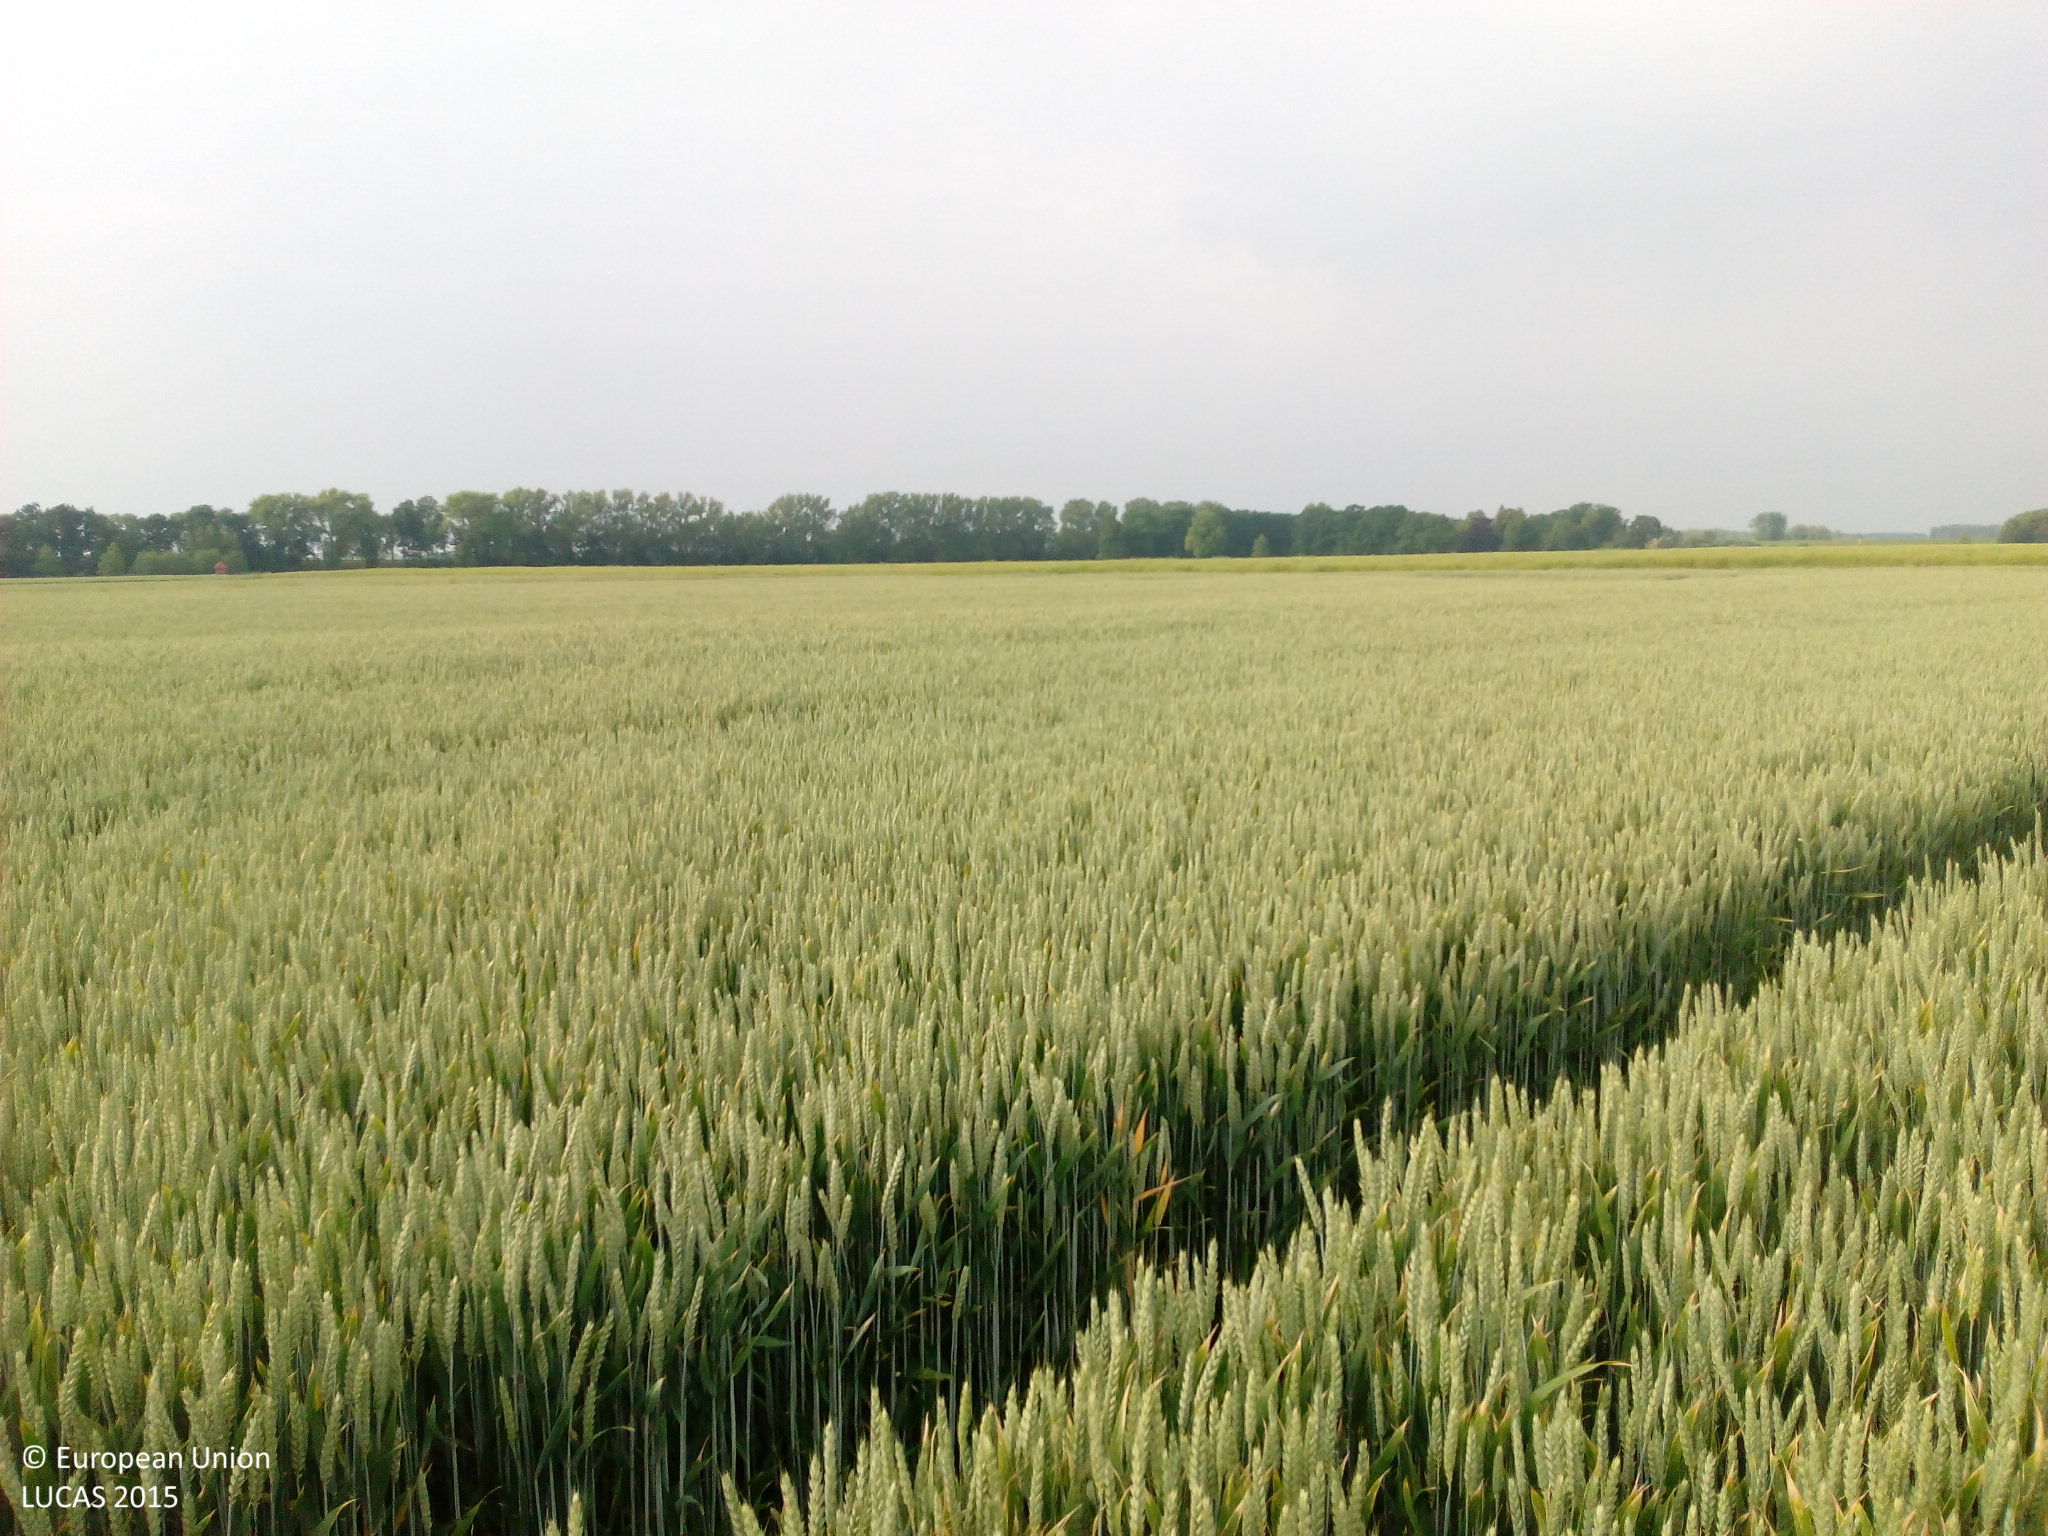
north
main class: Cropland
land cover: Common wheat
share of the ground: > 75 %
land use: Agriculture (excluding fallow land and kitchen gardens)
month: June
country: DE
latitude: 53.7415
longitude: 9.3181
